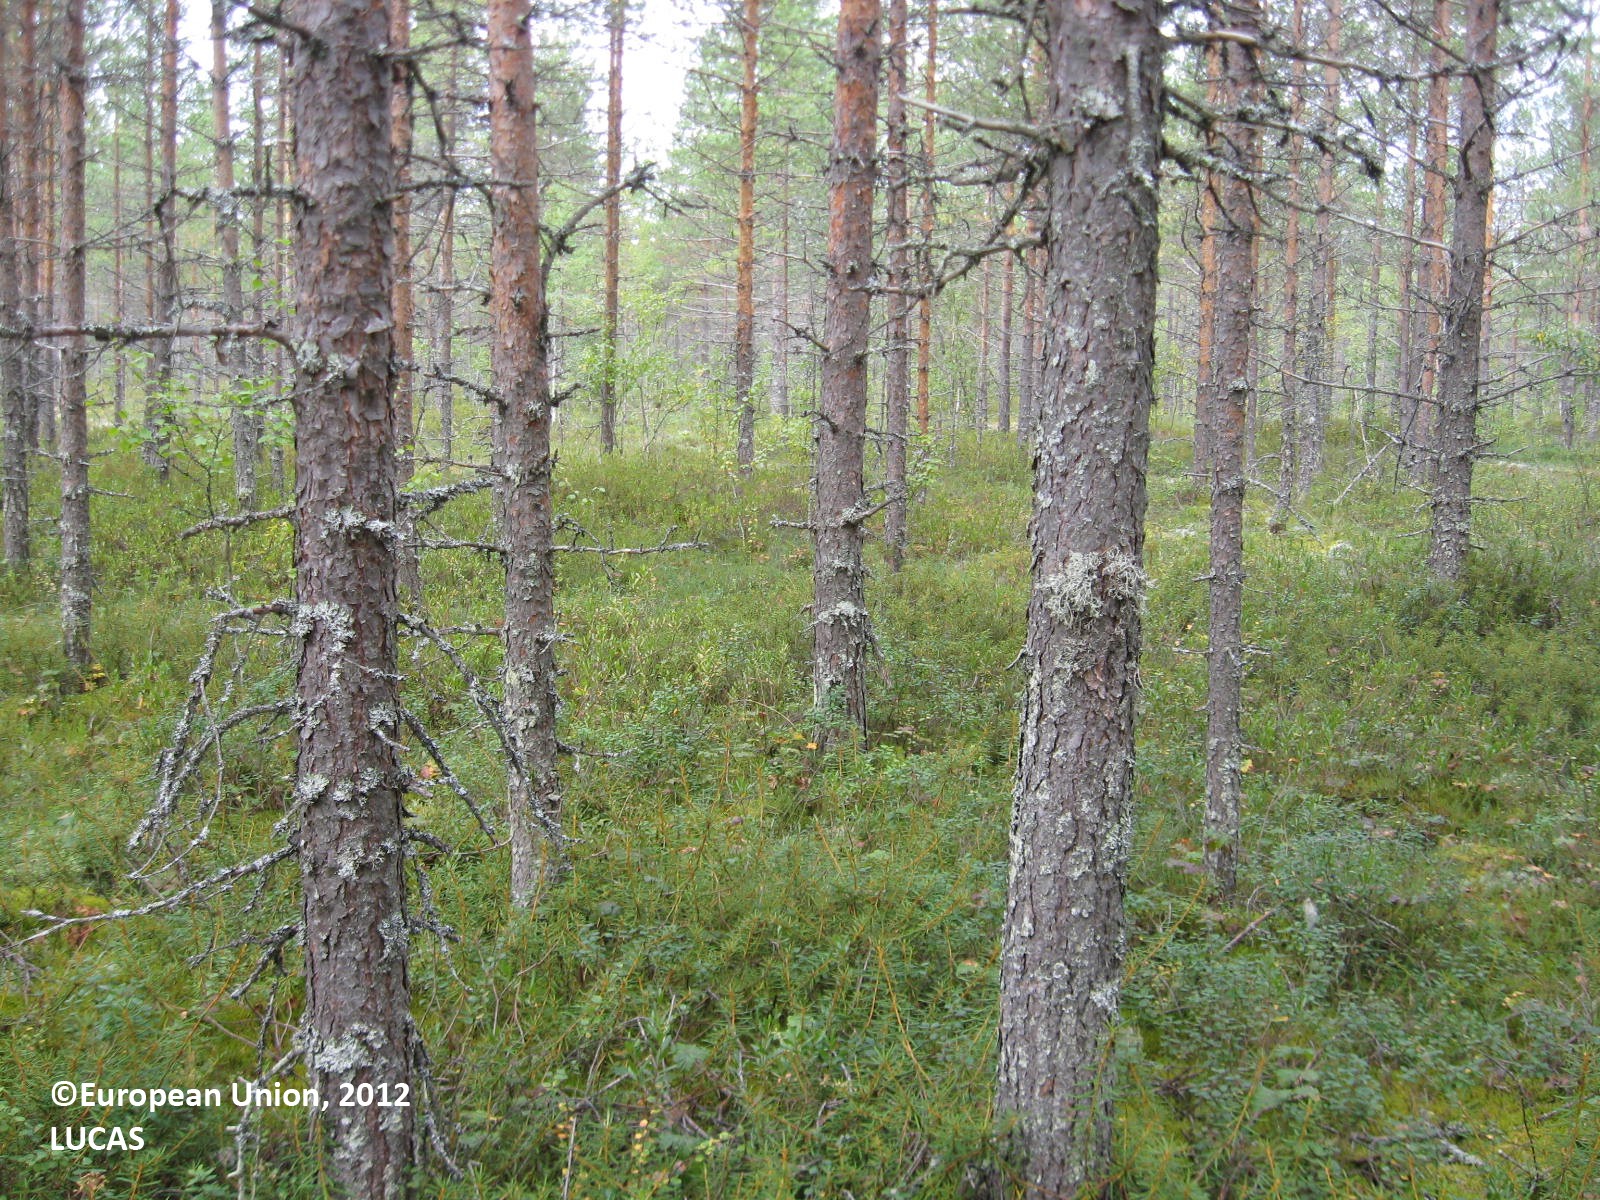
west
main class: Woodland
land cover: Pine dominated coniferous woodland
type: boreal forest
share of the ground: > 75 %
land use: Forestry
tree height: > 5 m
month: August
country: FI
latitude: 63.4472
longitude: 30.0824
